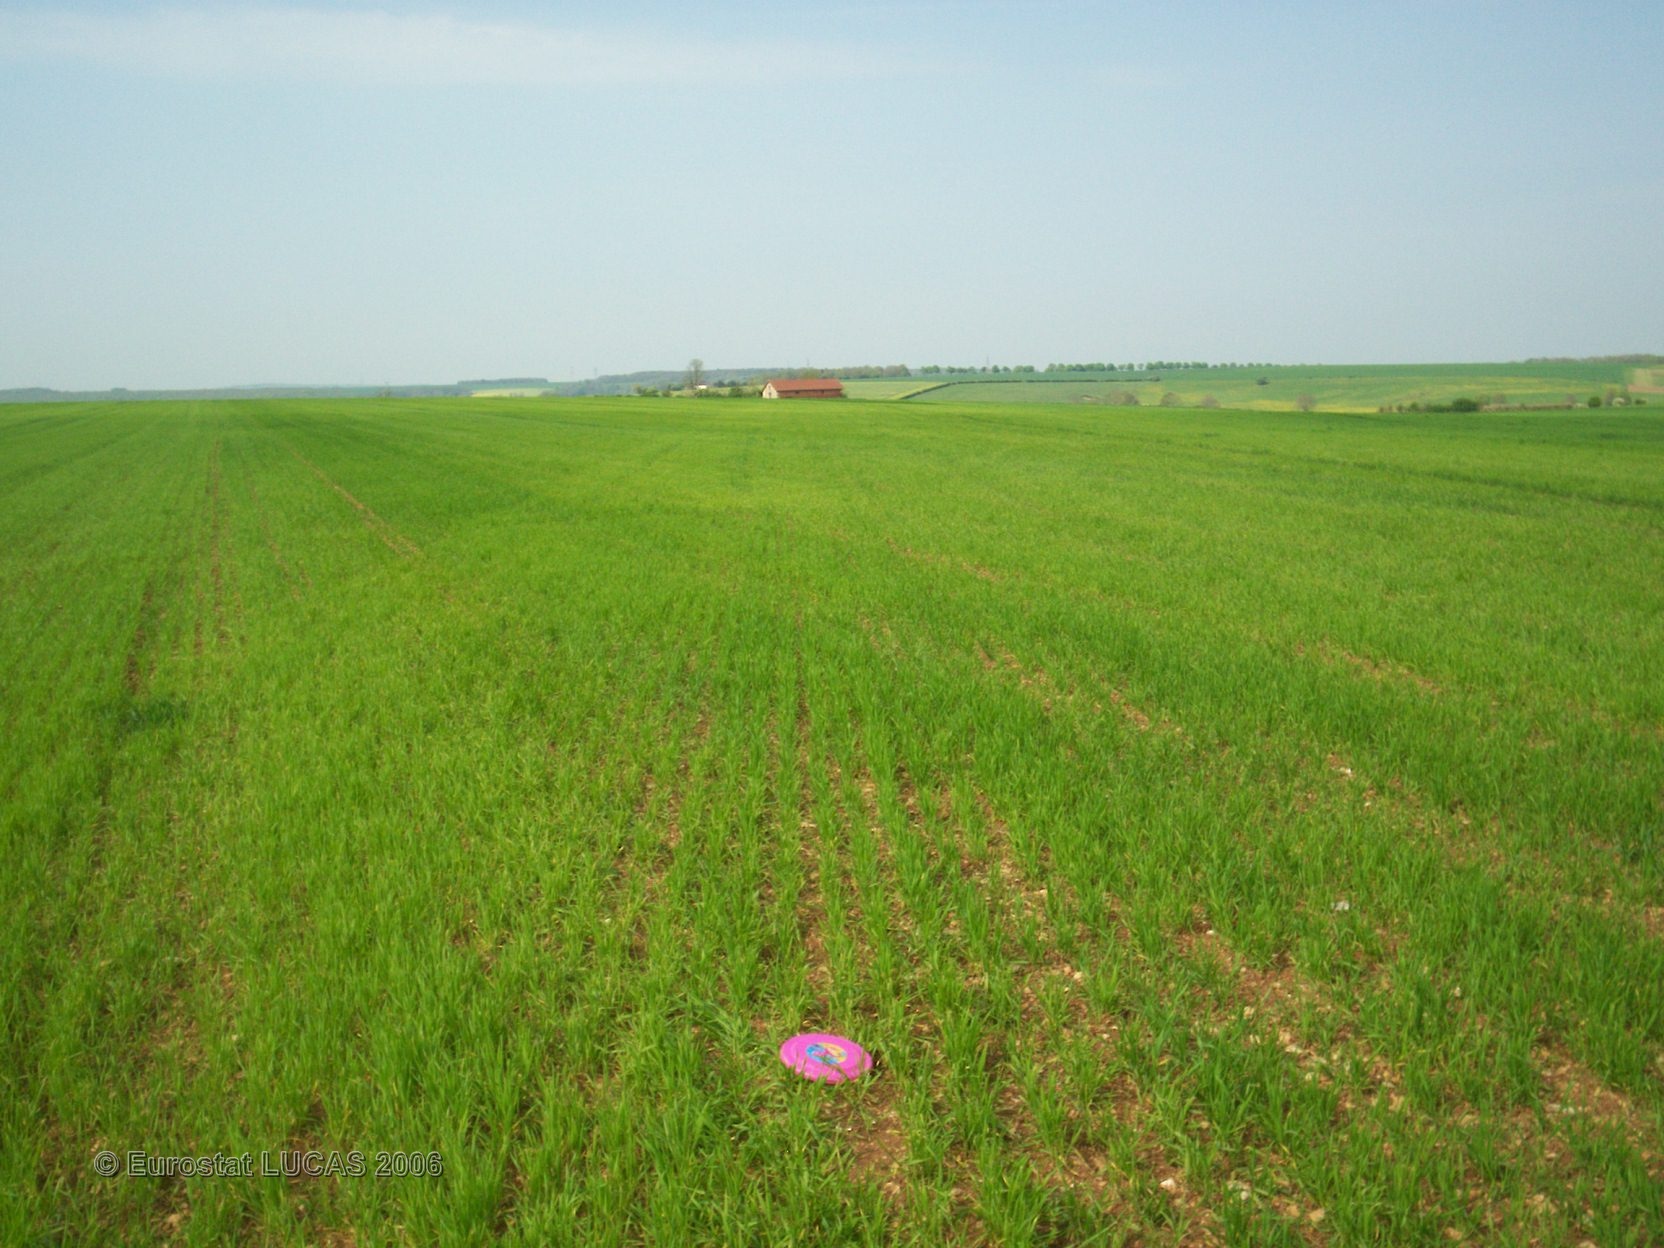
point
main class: Cropland
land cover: Common wheat
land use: Agriculture (excluding fallow land and kitchen gardens)
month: May
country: FR
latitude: 47.5523
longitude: 4.6441
